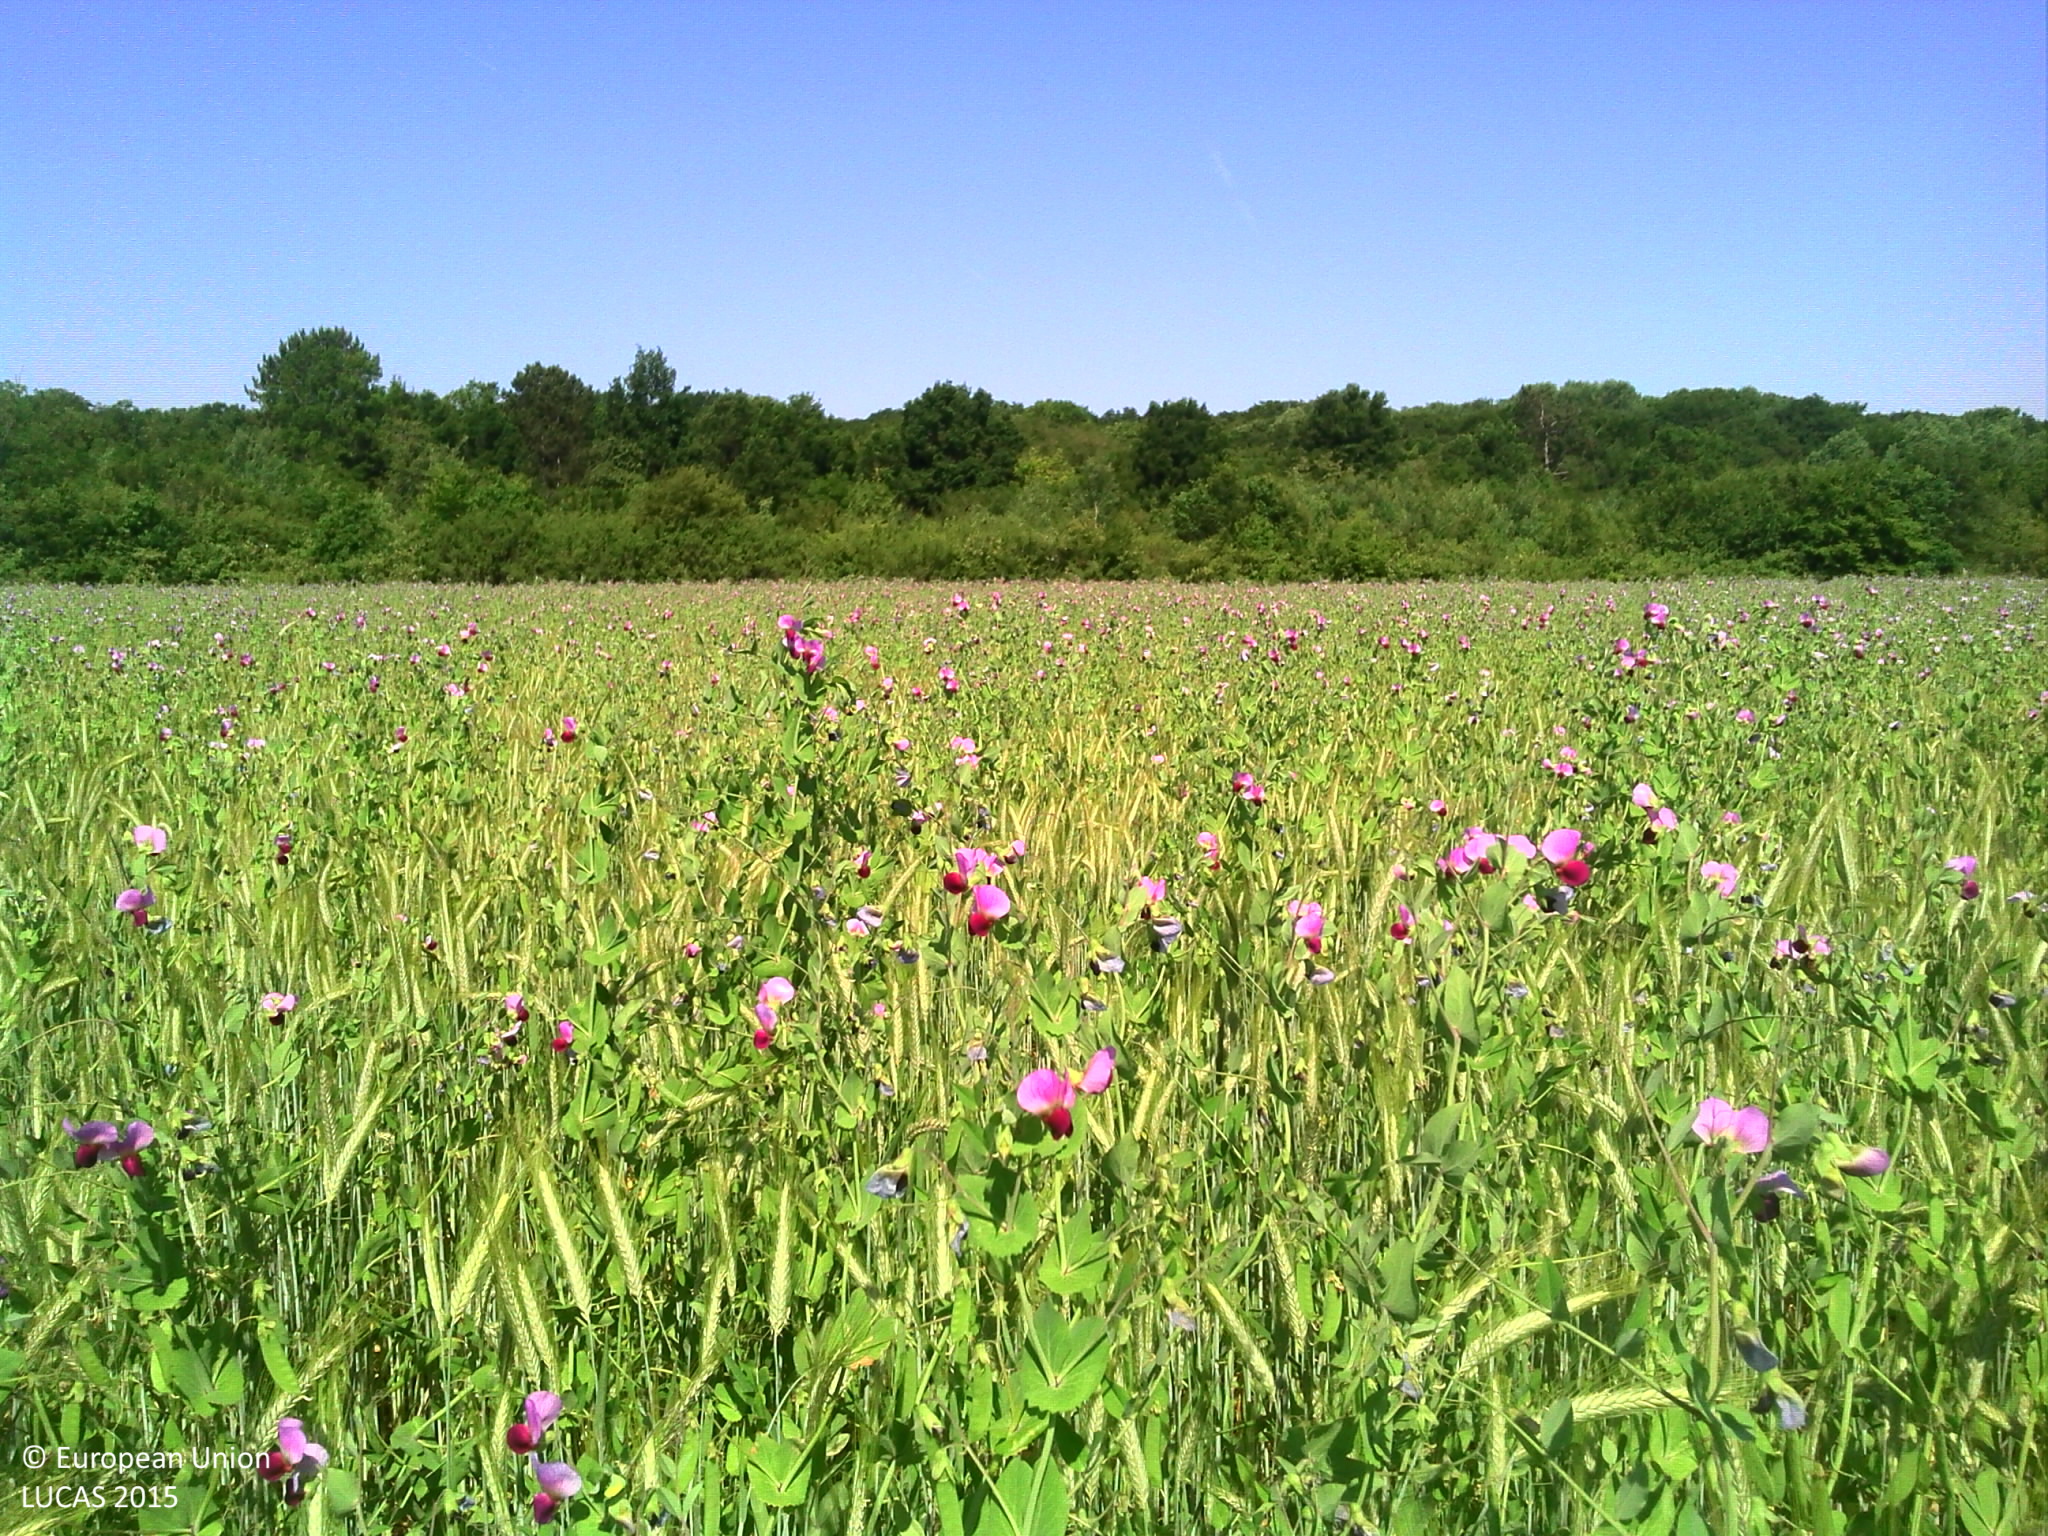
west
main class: Cropland
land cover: Mixed cereals for fodder
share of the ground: > 75 %
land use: Agriculture (excluding fallow land and kitchen gardens)
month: June
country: FR
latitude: 48.3931
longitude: 4.8798
